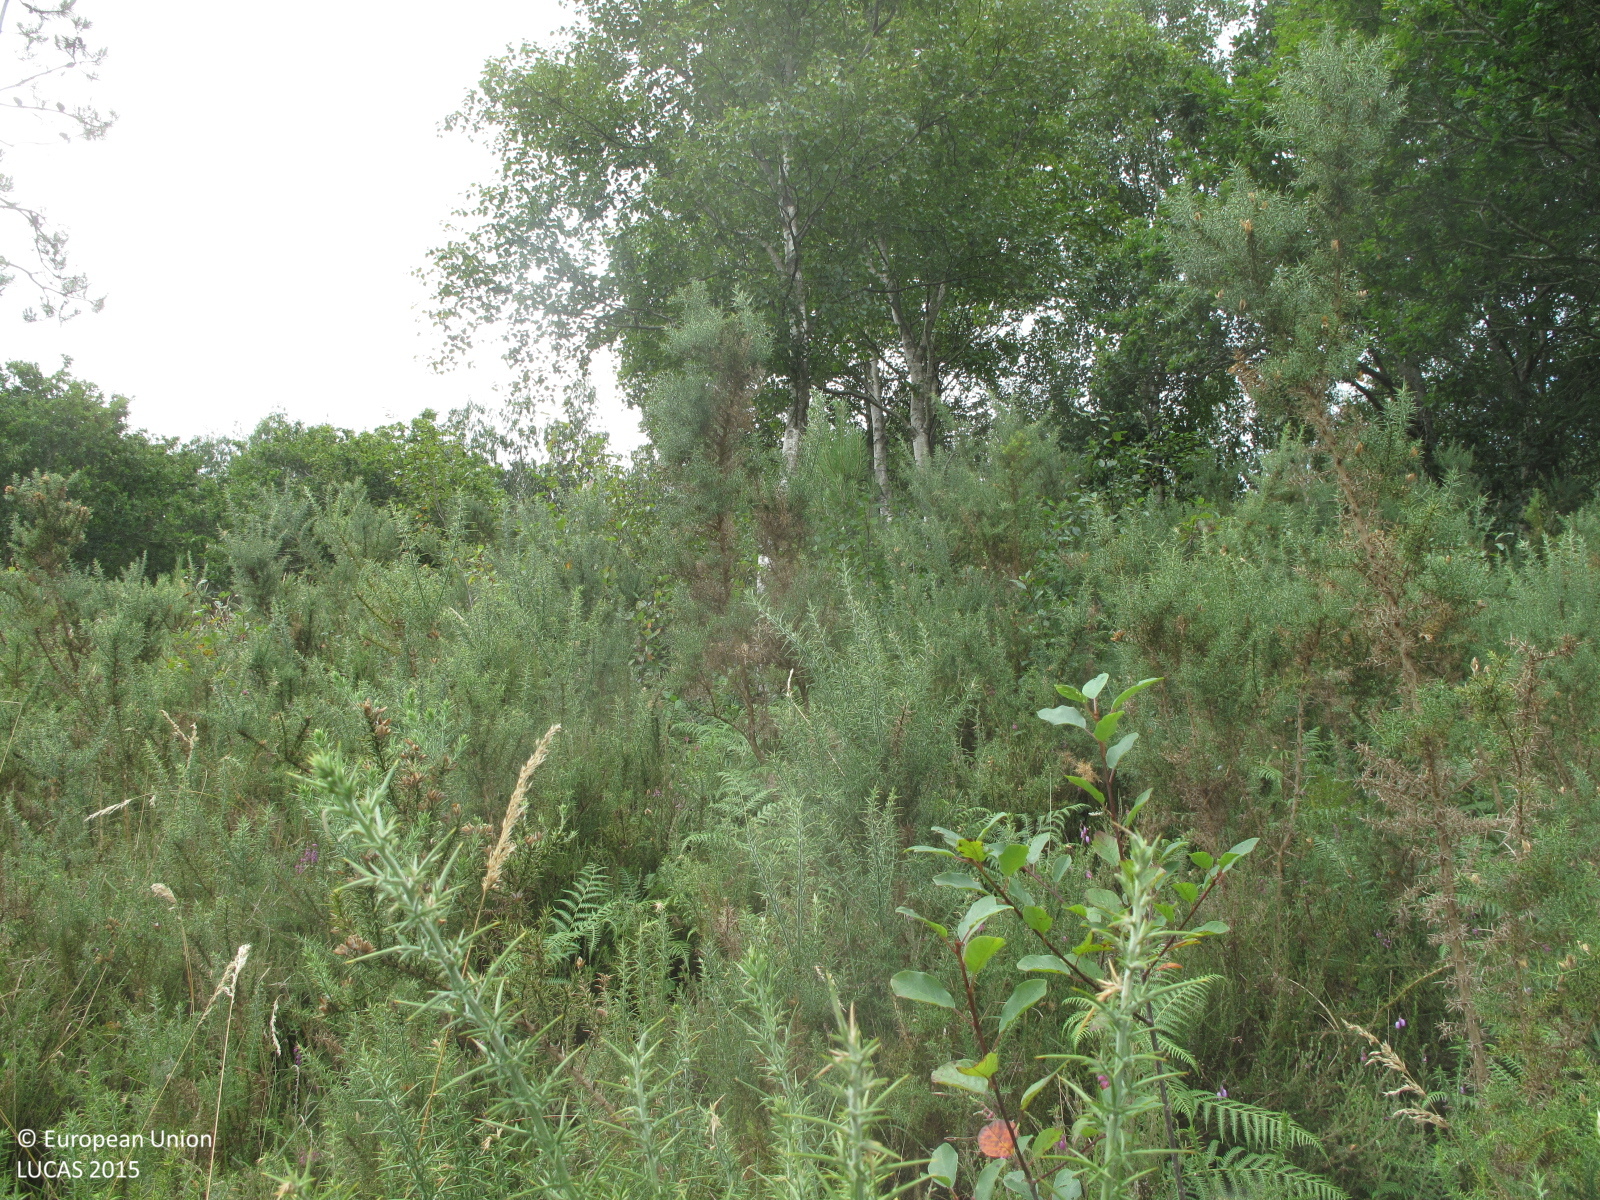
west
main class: Woodland
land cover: Broadleaved woodland
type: acidophilous oak and oak-birch forest
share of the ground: 10 - 25 %
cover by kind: shrubs 80 %, broadleaved forest trees 10 %, herbaceous plants 10 %
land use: Forestry
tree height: > 5 m
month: July
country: ES
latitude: 43.5218
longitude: -8.0750
